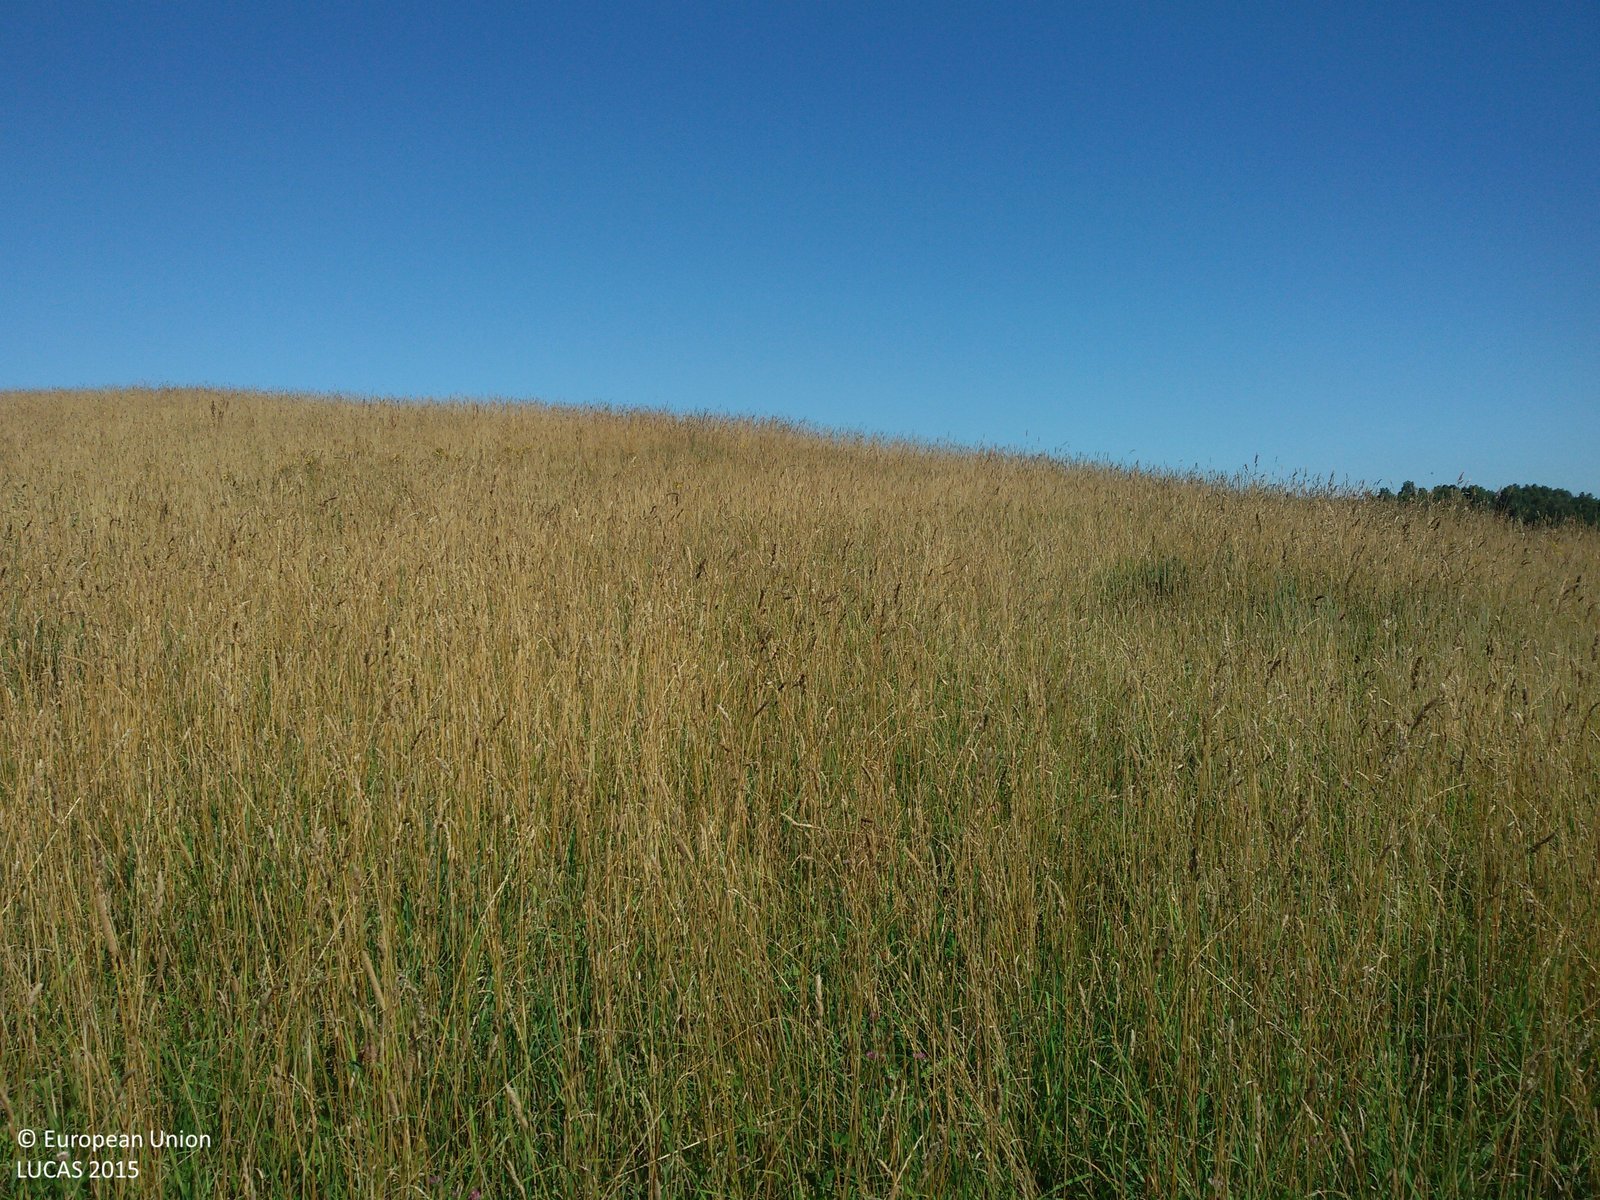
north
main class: Grassland
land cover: Grassland without tree/shrub cover
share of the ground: > 75 %
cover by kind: herbaceous plants 100 %
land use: Agriculture (excluding fallow land and kitchen gardens)
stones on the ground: < 10 %
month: August
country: PL
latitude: 54.1412
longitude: 17.2501
